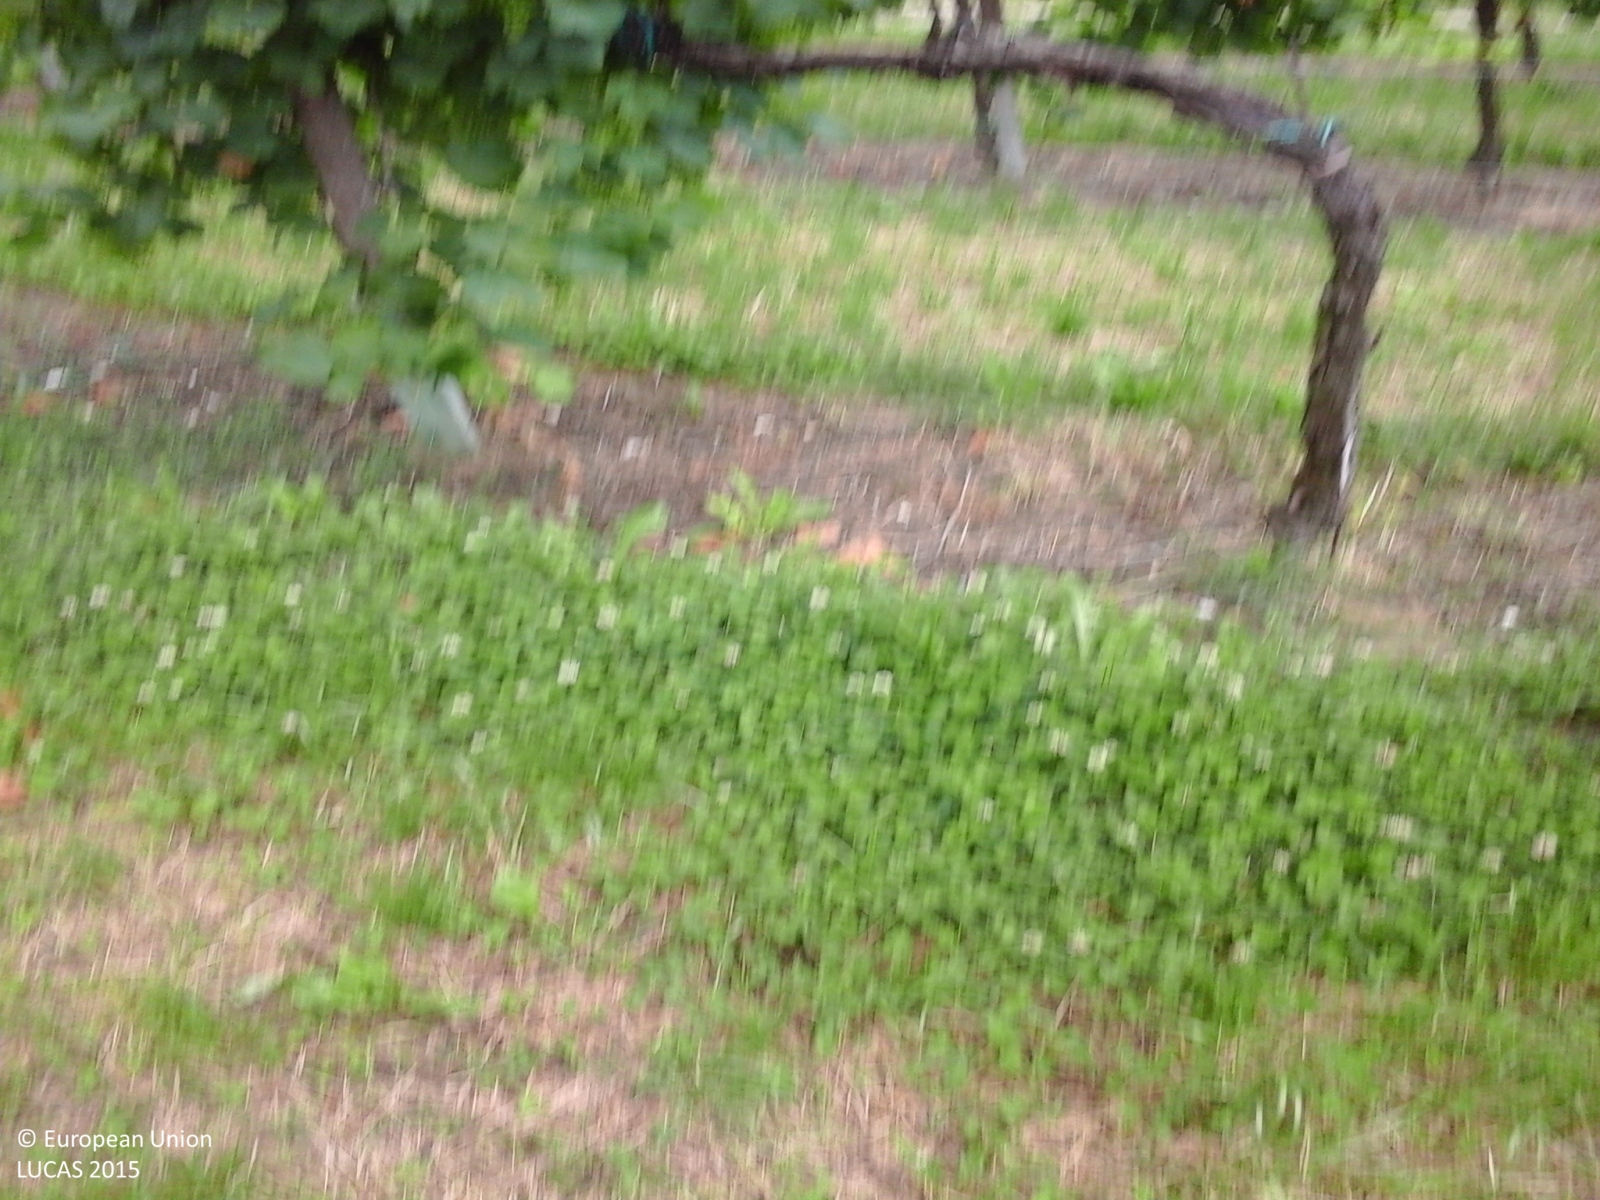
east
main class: Cropland
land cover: Vineyards
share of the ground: 25 - 50 %
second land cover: Grassland without tree/shrub cover
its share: > 75 %
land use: Agriculture (excluding fallow land and kitchen gardens)
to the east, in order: Vineyards; Grassland without tree/shrub cover; Tracks; Soya; Grass margins; Artificial constructions in urban areas; Grass margins; Ditches and canals; Spontaneously vegetated surfaces; Managed hedges; Grassland without tree/shrub cover; Managed hedges; Lucerne; Spontaneously vegetated surfaces; Vineyards; Ditches and canals; Lines of trees; Grass margins; Fences; Grassland with sparse tree/shrub cover
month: June
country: IT
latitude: 45.9636
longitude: 12.4099
